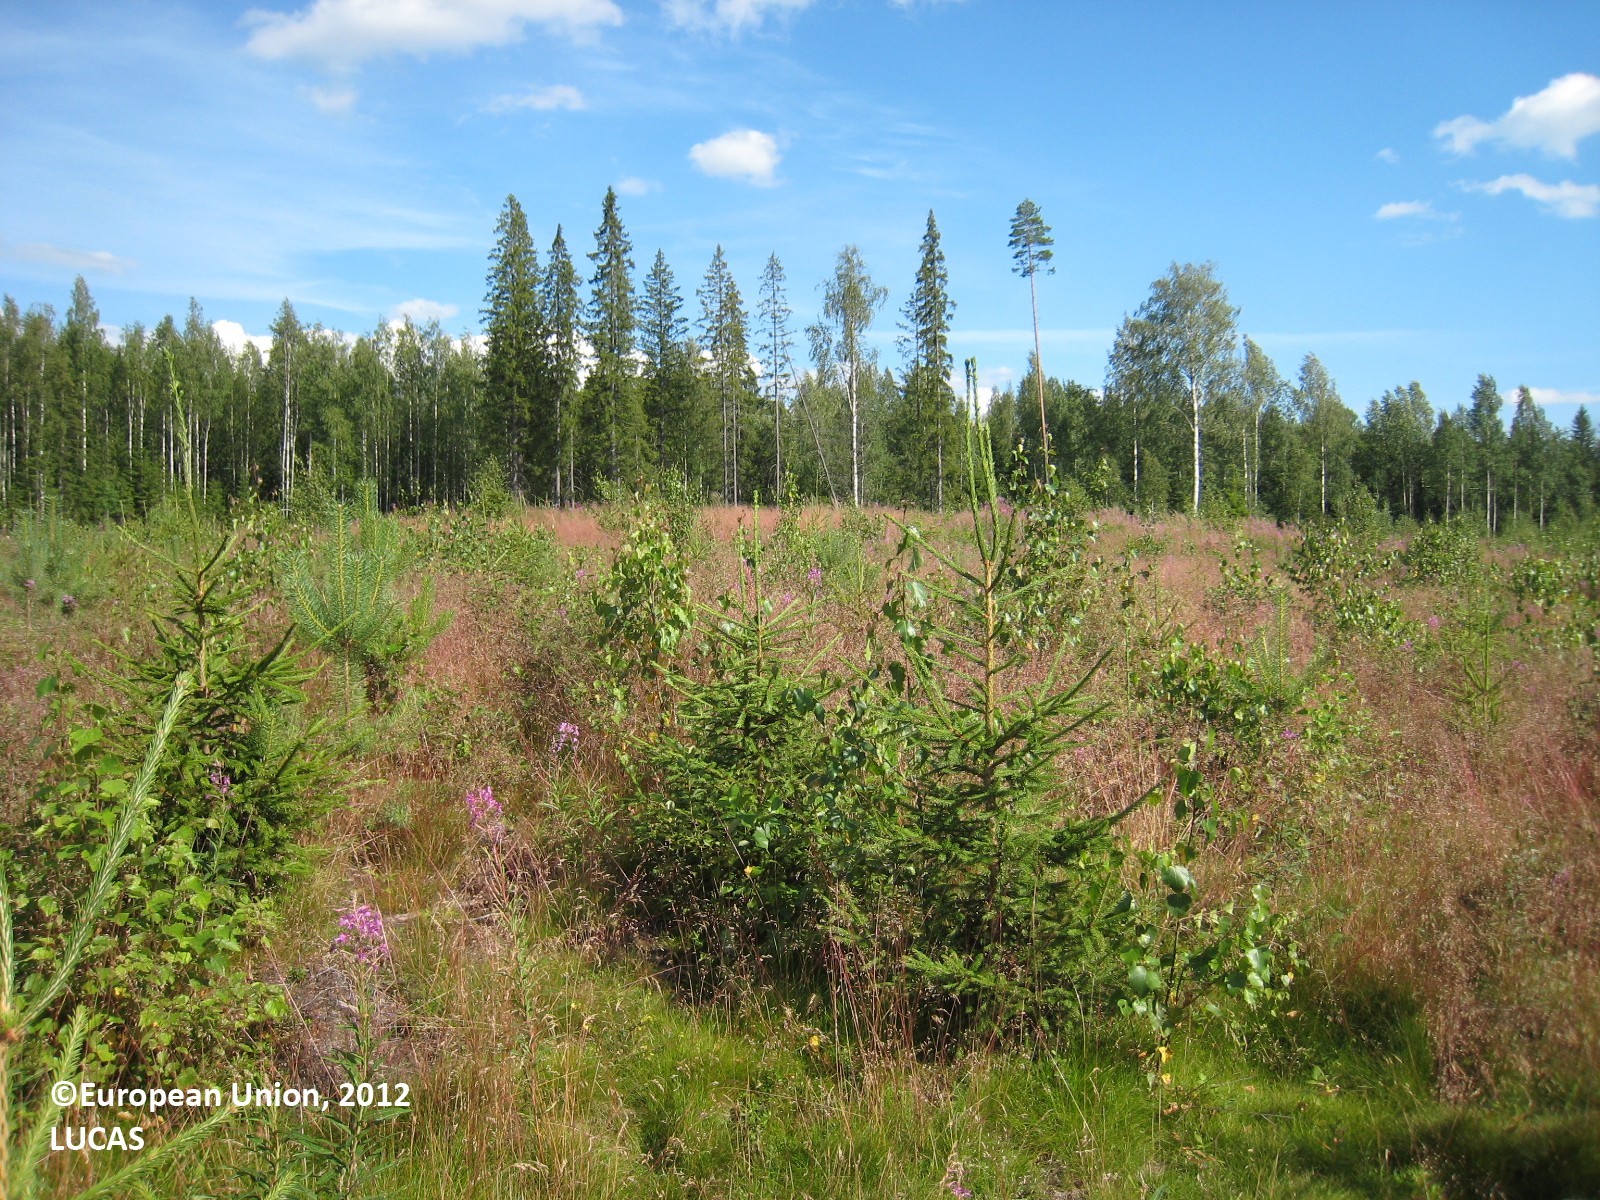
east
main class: Woodland
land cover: Other mixed woodland
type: boreal forest
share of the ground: 25 - 50 %
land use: Forestry
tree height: < 5 m
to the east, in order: Other mixed woodland; Spruce dominated mixed woodland; Dry stone walls; Spruce dominated mixed woodland; Ditches and canals; Grassland with sparse tree/shrub cover; Ditches and canals; Spruce dominated mixed woodland; Ditches and canals; Sand; Electric lines; Railways; Sand; Ditches and canals; Grassland with sparse tree/shrub cover; Spruce dominated mixed woodland
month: July
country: FI
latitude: 62.6937
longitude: 27.2947
